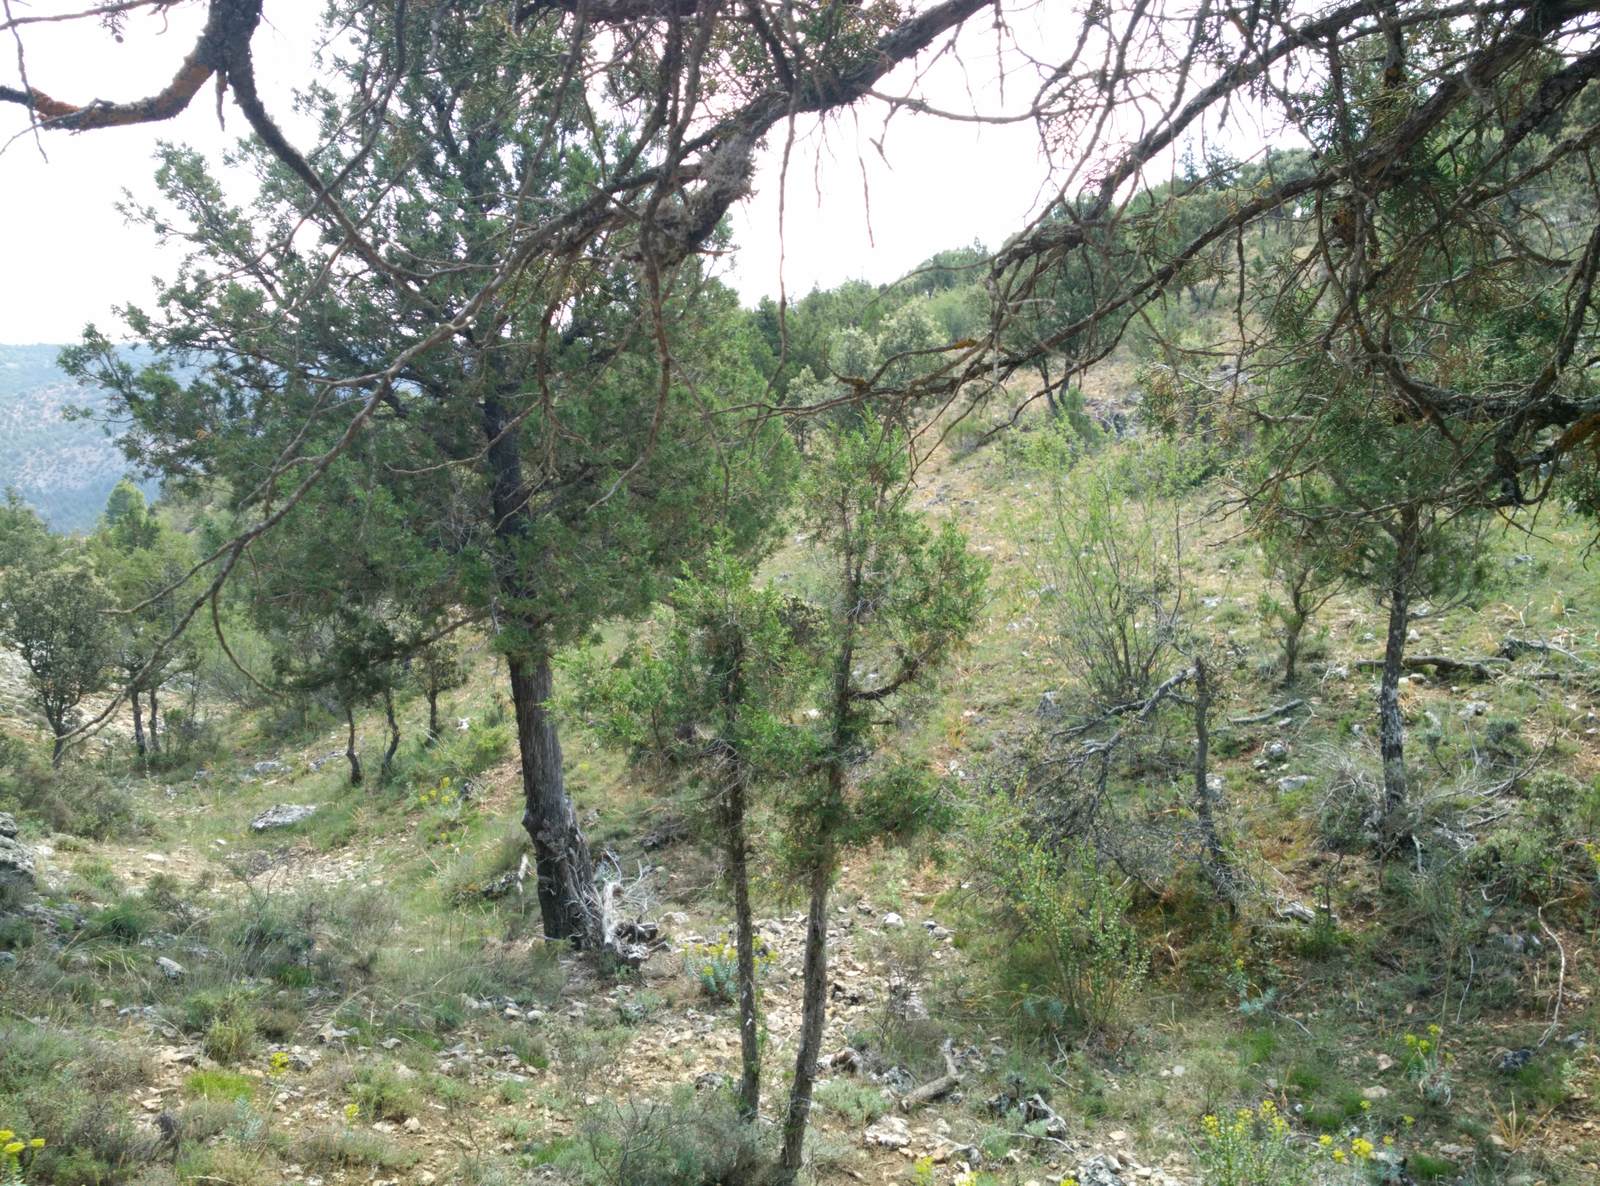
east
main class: Woodland
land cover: Other coniferous woodland
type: coniferous forest of the mediterranean region
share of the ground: 25 - 50 %
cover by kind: unconsolidated bare surface 45 %, coniferous forest trees 40 %, shrubs 10 %, herbaceous plants 5 %
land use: Semi-natural and natural areas not in use
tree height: > 5 m
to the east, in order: Other coniferous woodland; Rock outcrops; Other mixed woodland
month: June
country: ES
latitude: 40.7221
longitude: -1.9432
